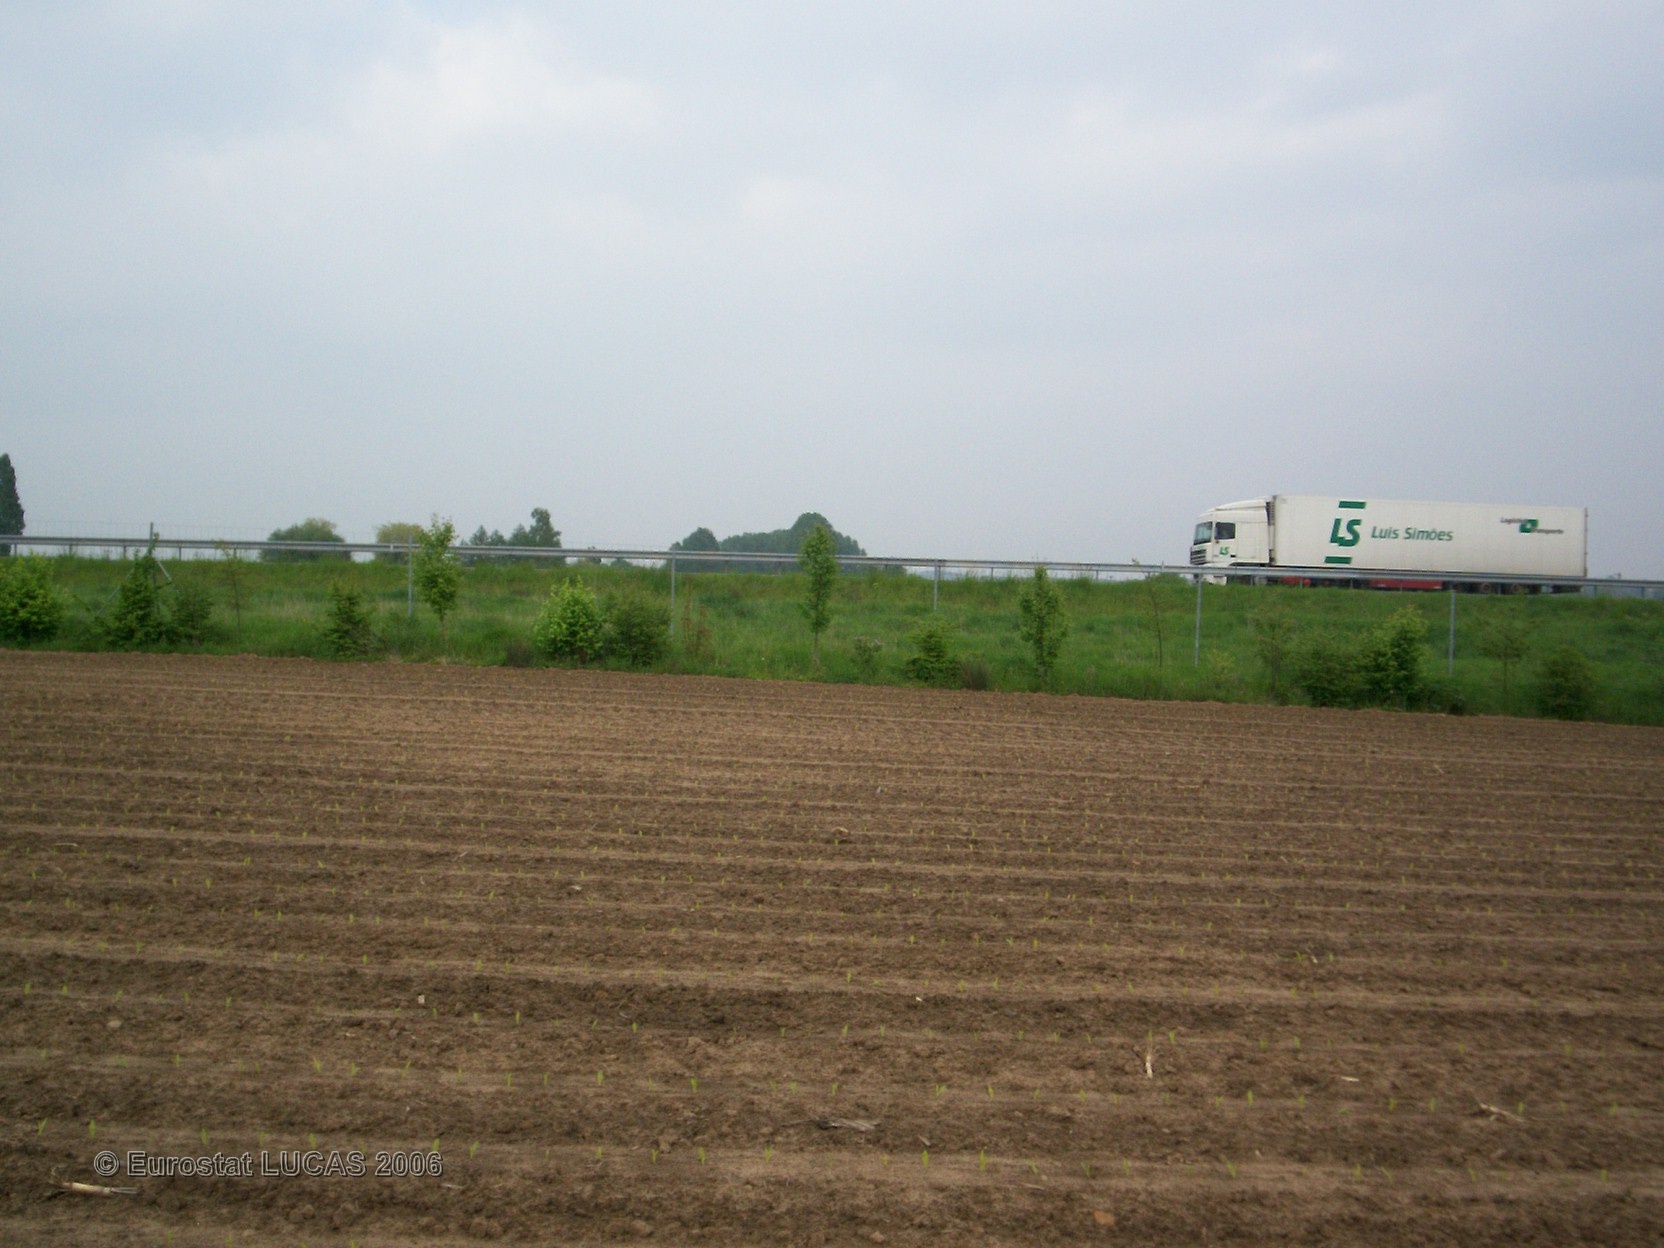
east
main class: Cropland
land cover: Maize
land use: Agriculture (excluding fallow land and kitchen gardens)
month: May
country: FR
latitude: 47.9039
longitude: 0.3031
